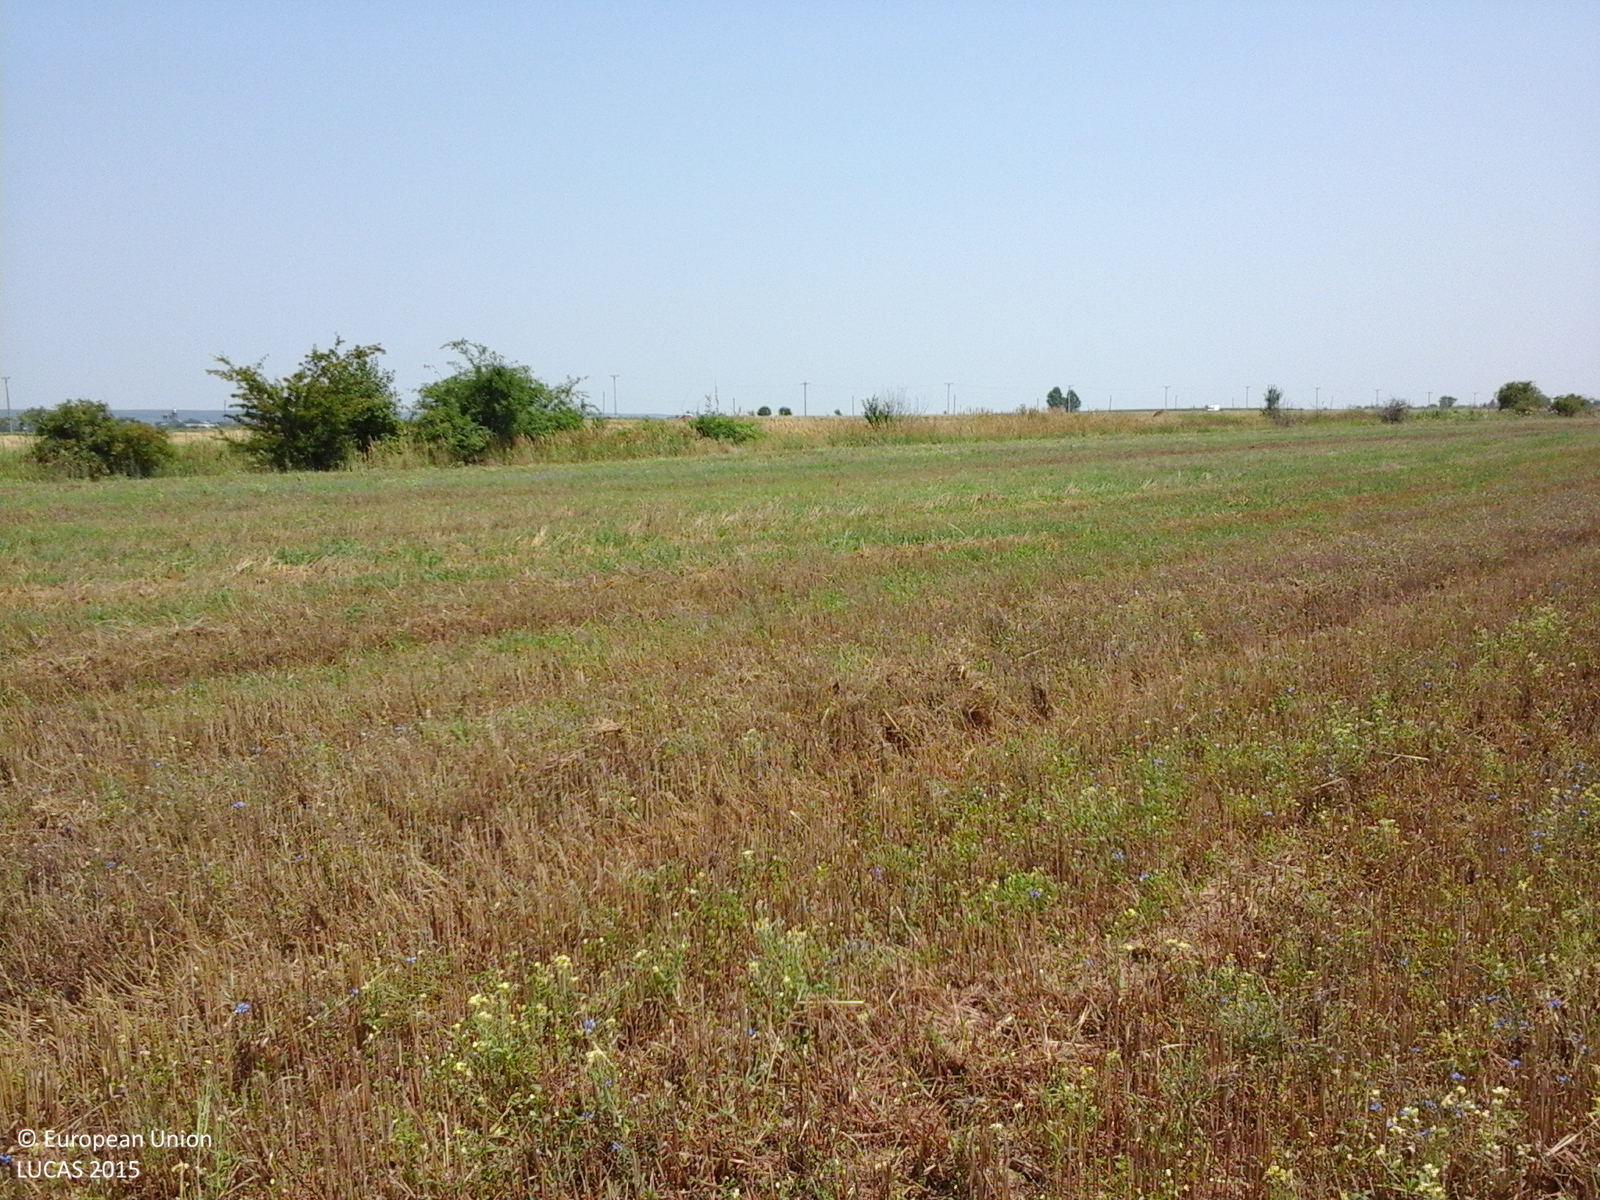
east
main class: Cropland
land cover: Common wheat
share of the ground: < 10 %
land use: Agriculture (excluding fallow land and kitchen gardens)
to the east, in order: Common wheat; Ditches and canals; Common wheat
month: July
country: RO
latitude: 44.7996
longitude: 25.6863
